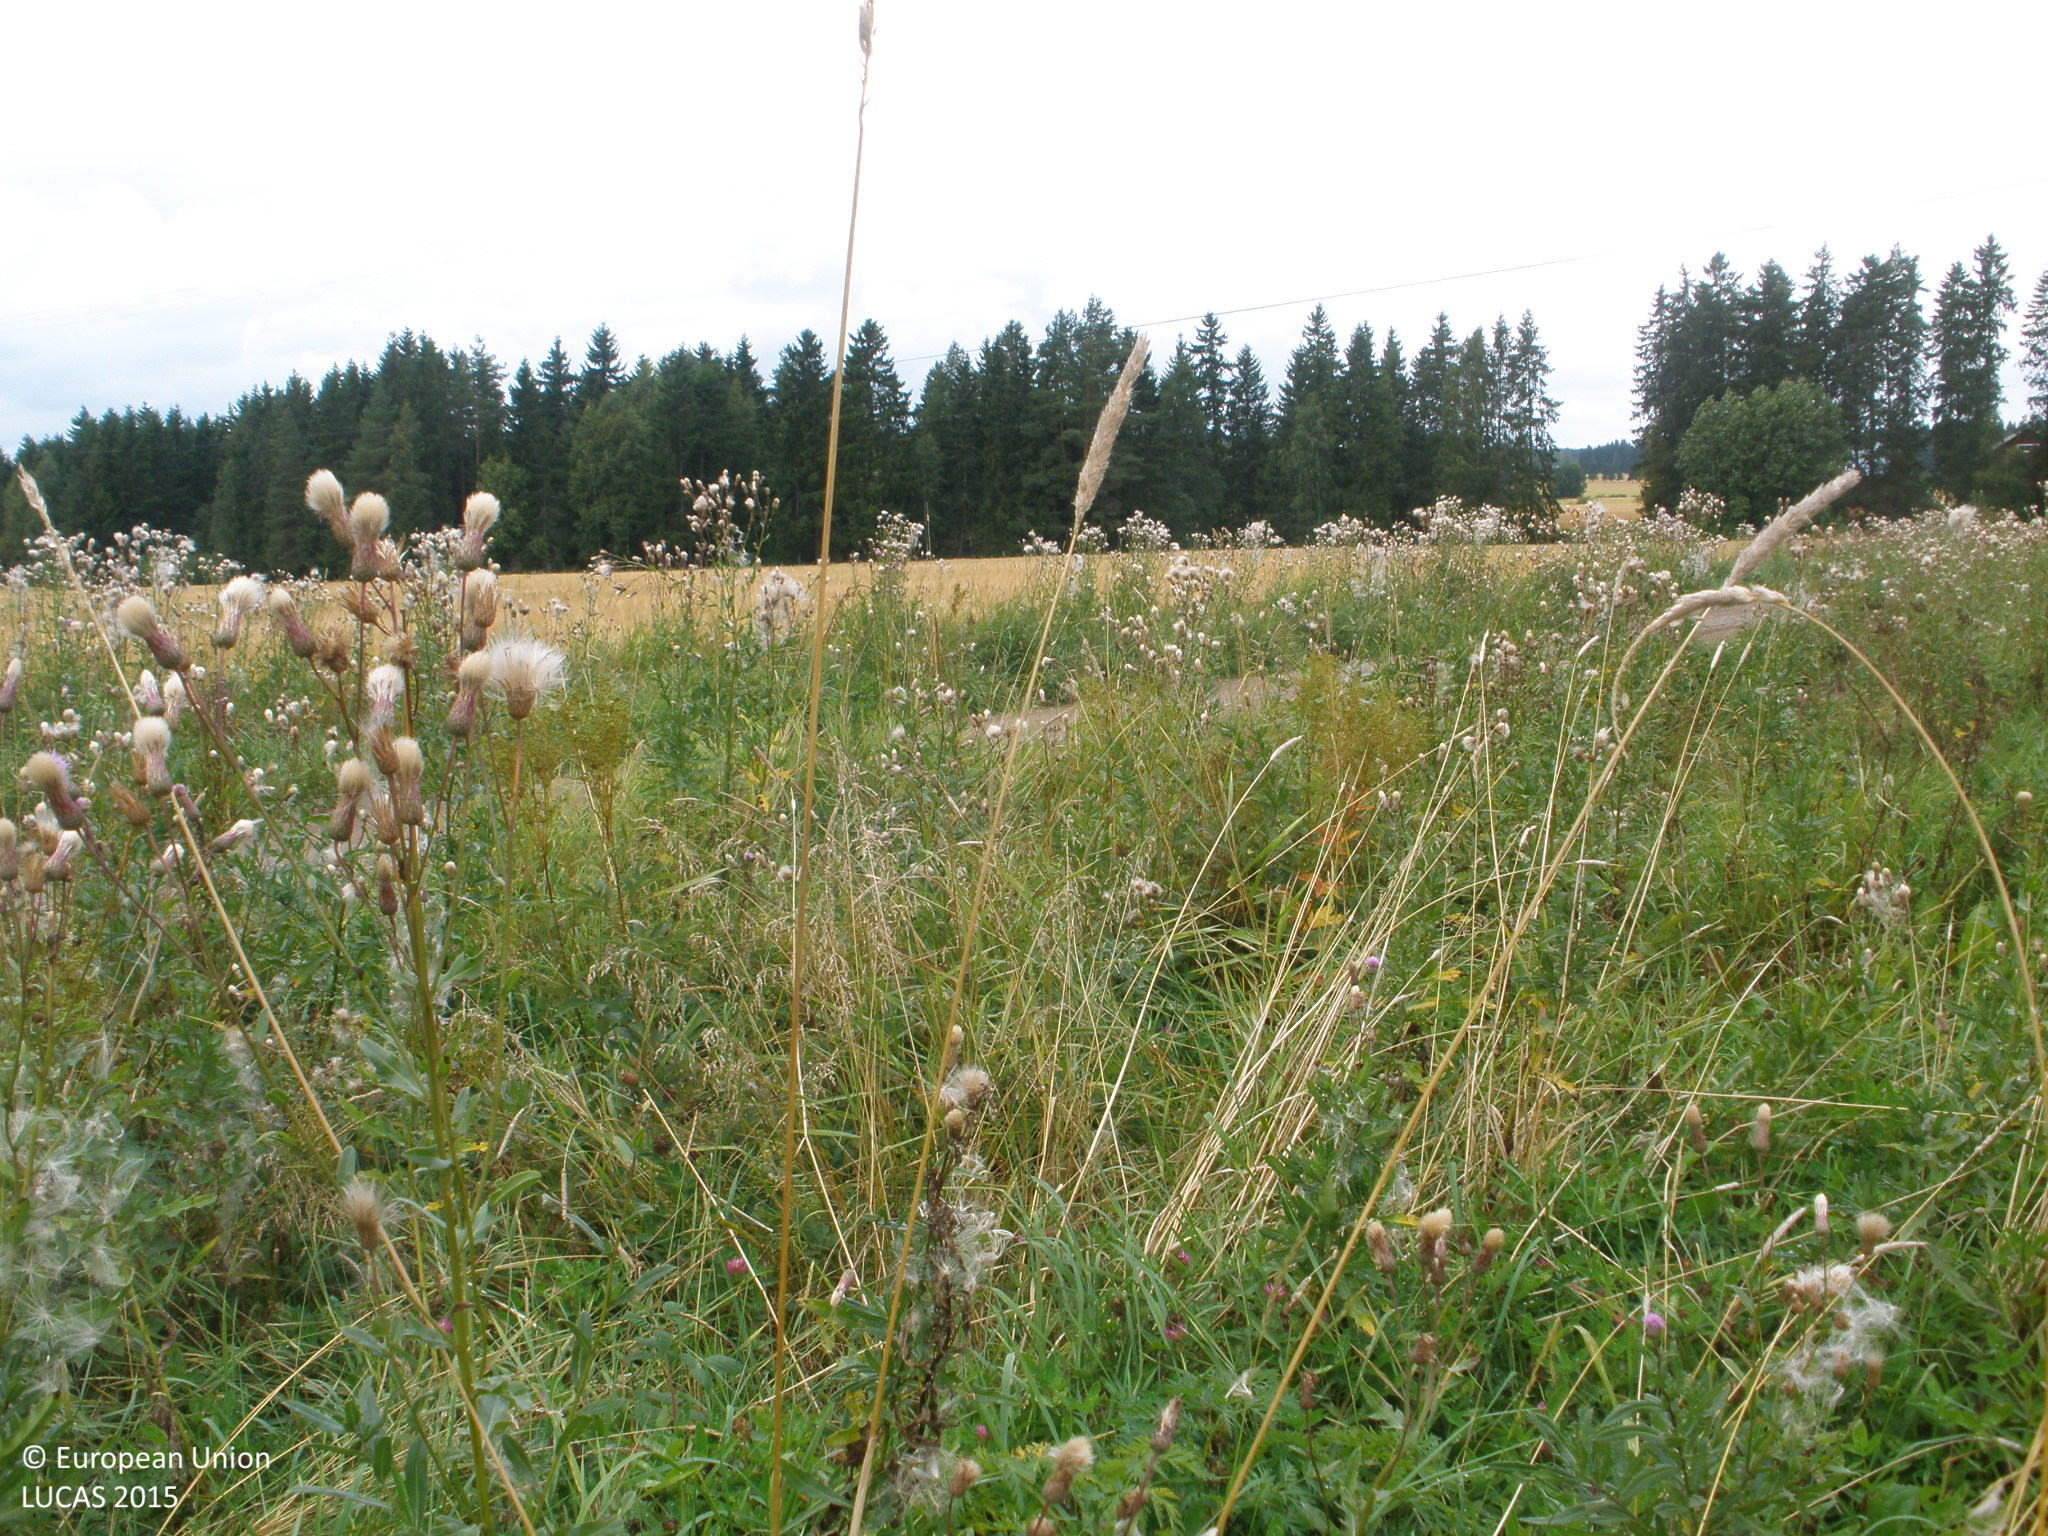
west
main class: Cropland
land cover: Barley
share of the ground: > 75 %
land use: Agriculture (excluding fallow land and kitchen gardens)
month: August
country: FI
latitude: 60.5822
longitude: 23.5755
